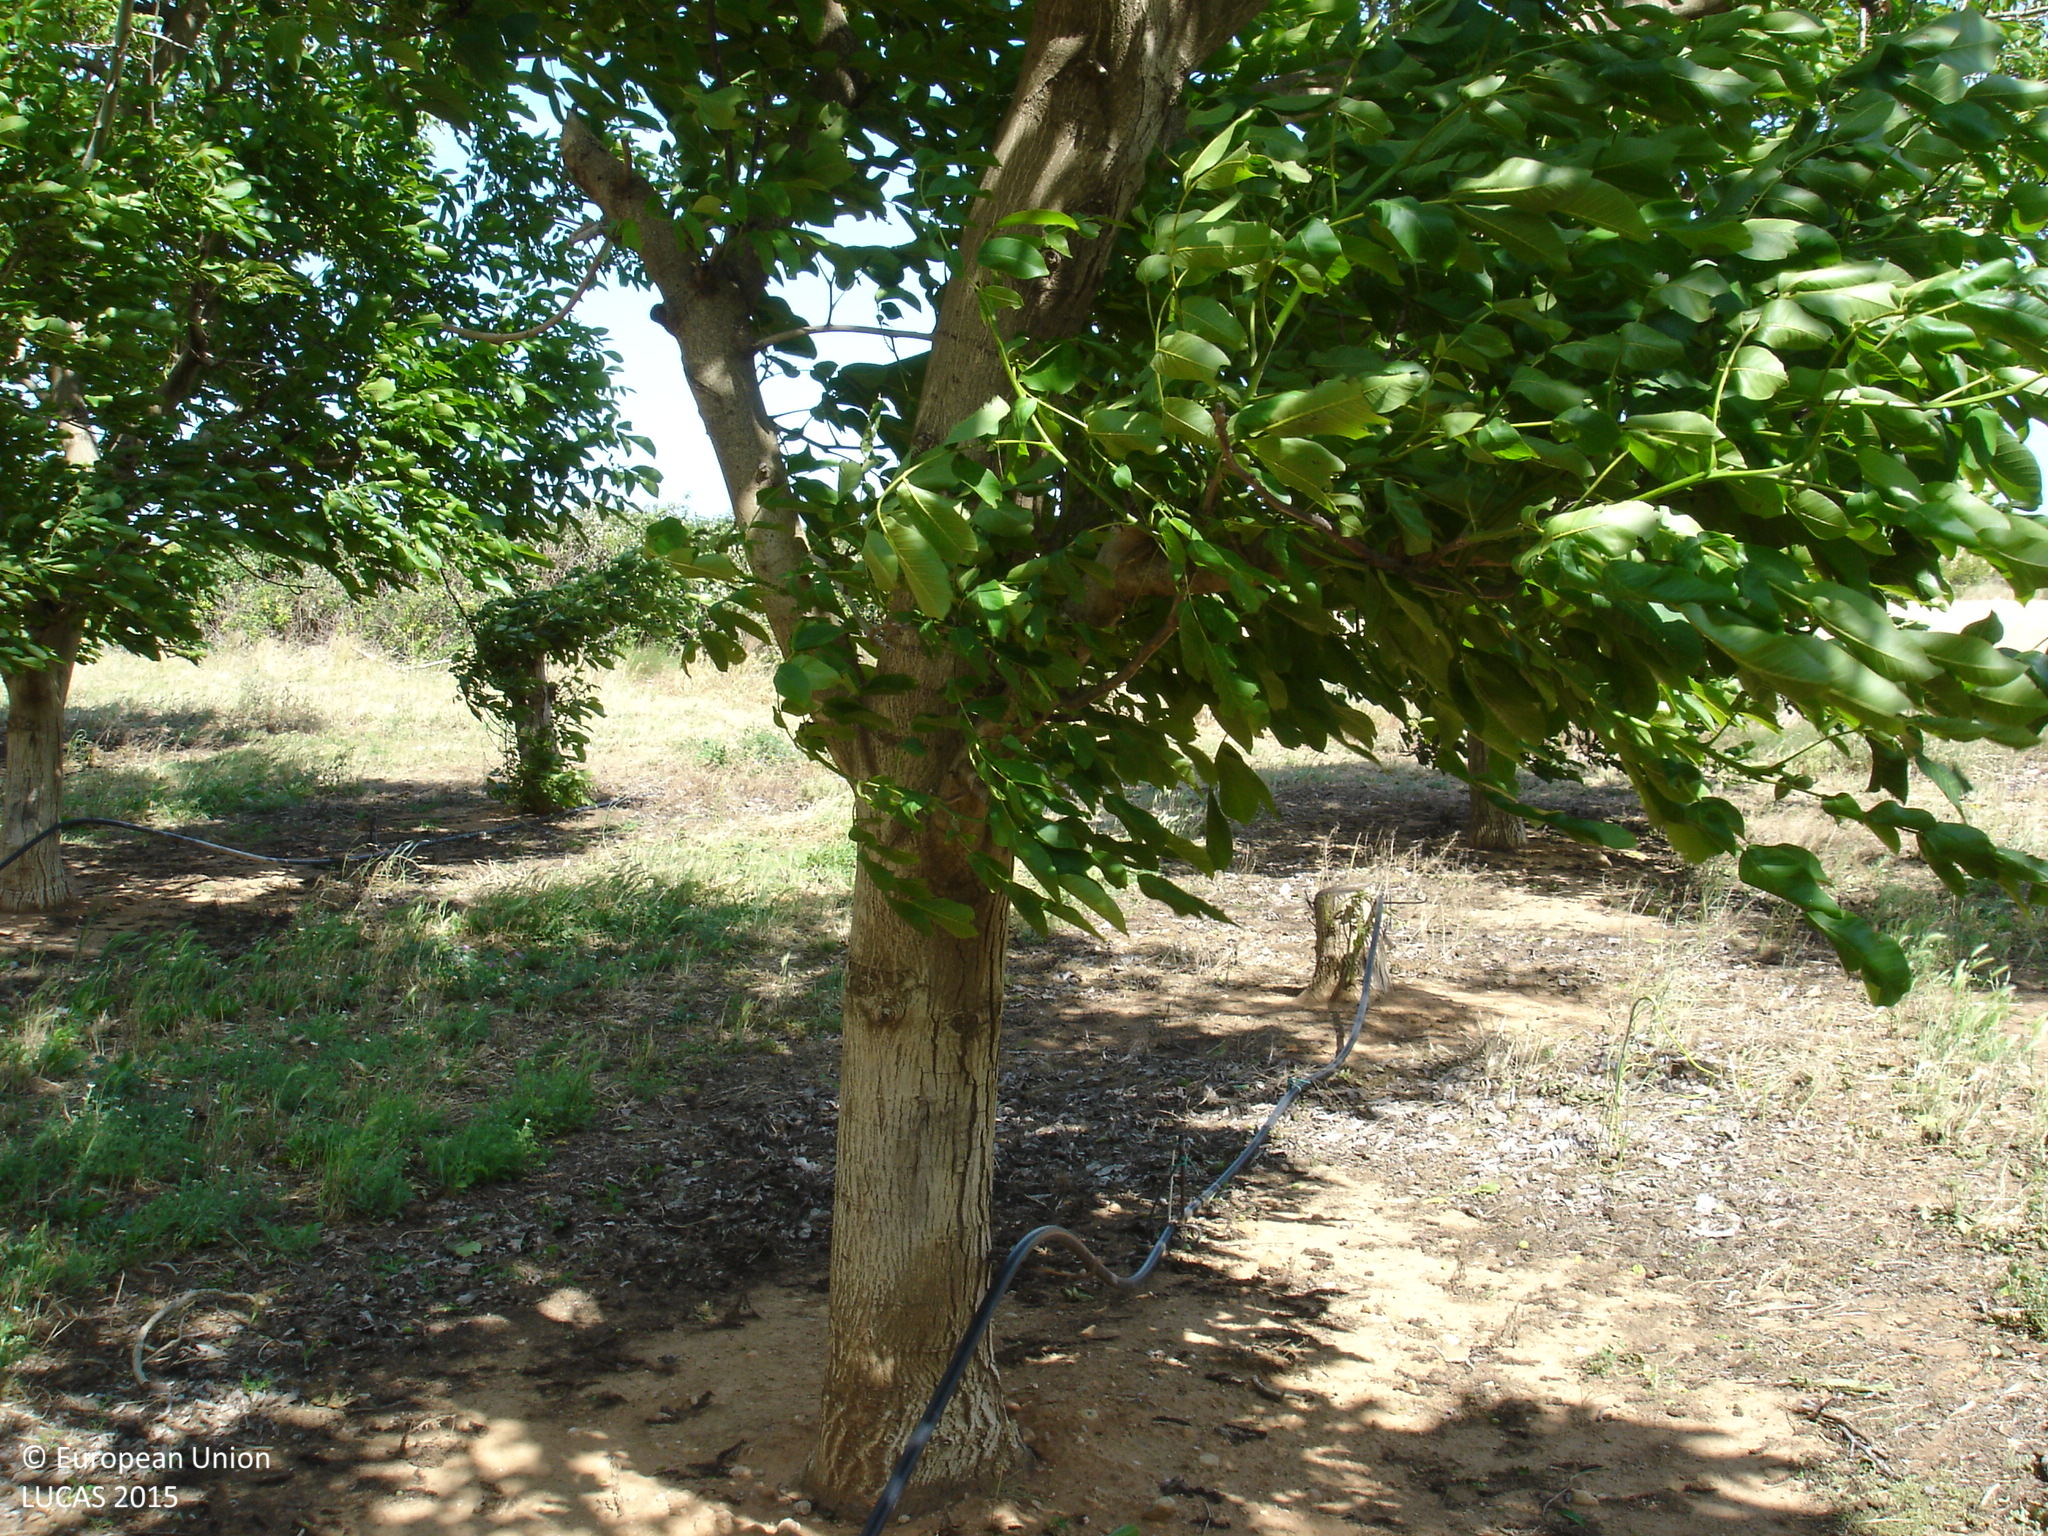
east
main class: Cropland
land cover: Nuts trees
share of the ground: > 75 %
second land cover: Spontaneously vegetated surfaces
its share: 25 - 50 %
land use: Agriculture (excluding fallow land and kitchen gardens)
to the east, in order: Nuts trees; Spontaneously vegetated surfaces; Grass margins; Artificial constructions; Grass margins; Barley; Grass margins; Tracks; Grass margins; Barley; Oats; Grassland with sparse tree/shrub cover; Artificial constructions; Grassland with sparse tree/shrub cover; Paved roads, cycling and walking lanes; Grassland with sparse tree/shrub cover; Tracks; Maize
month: May
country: ES
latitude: 42.1438
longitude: 3.0574
